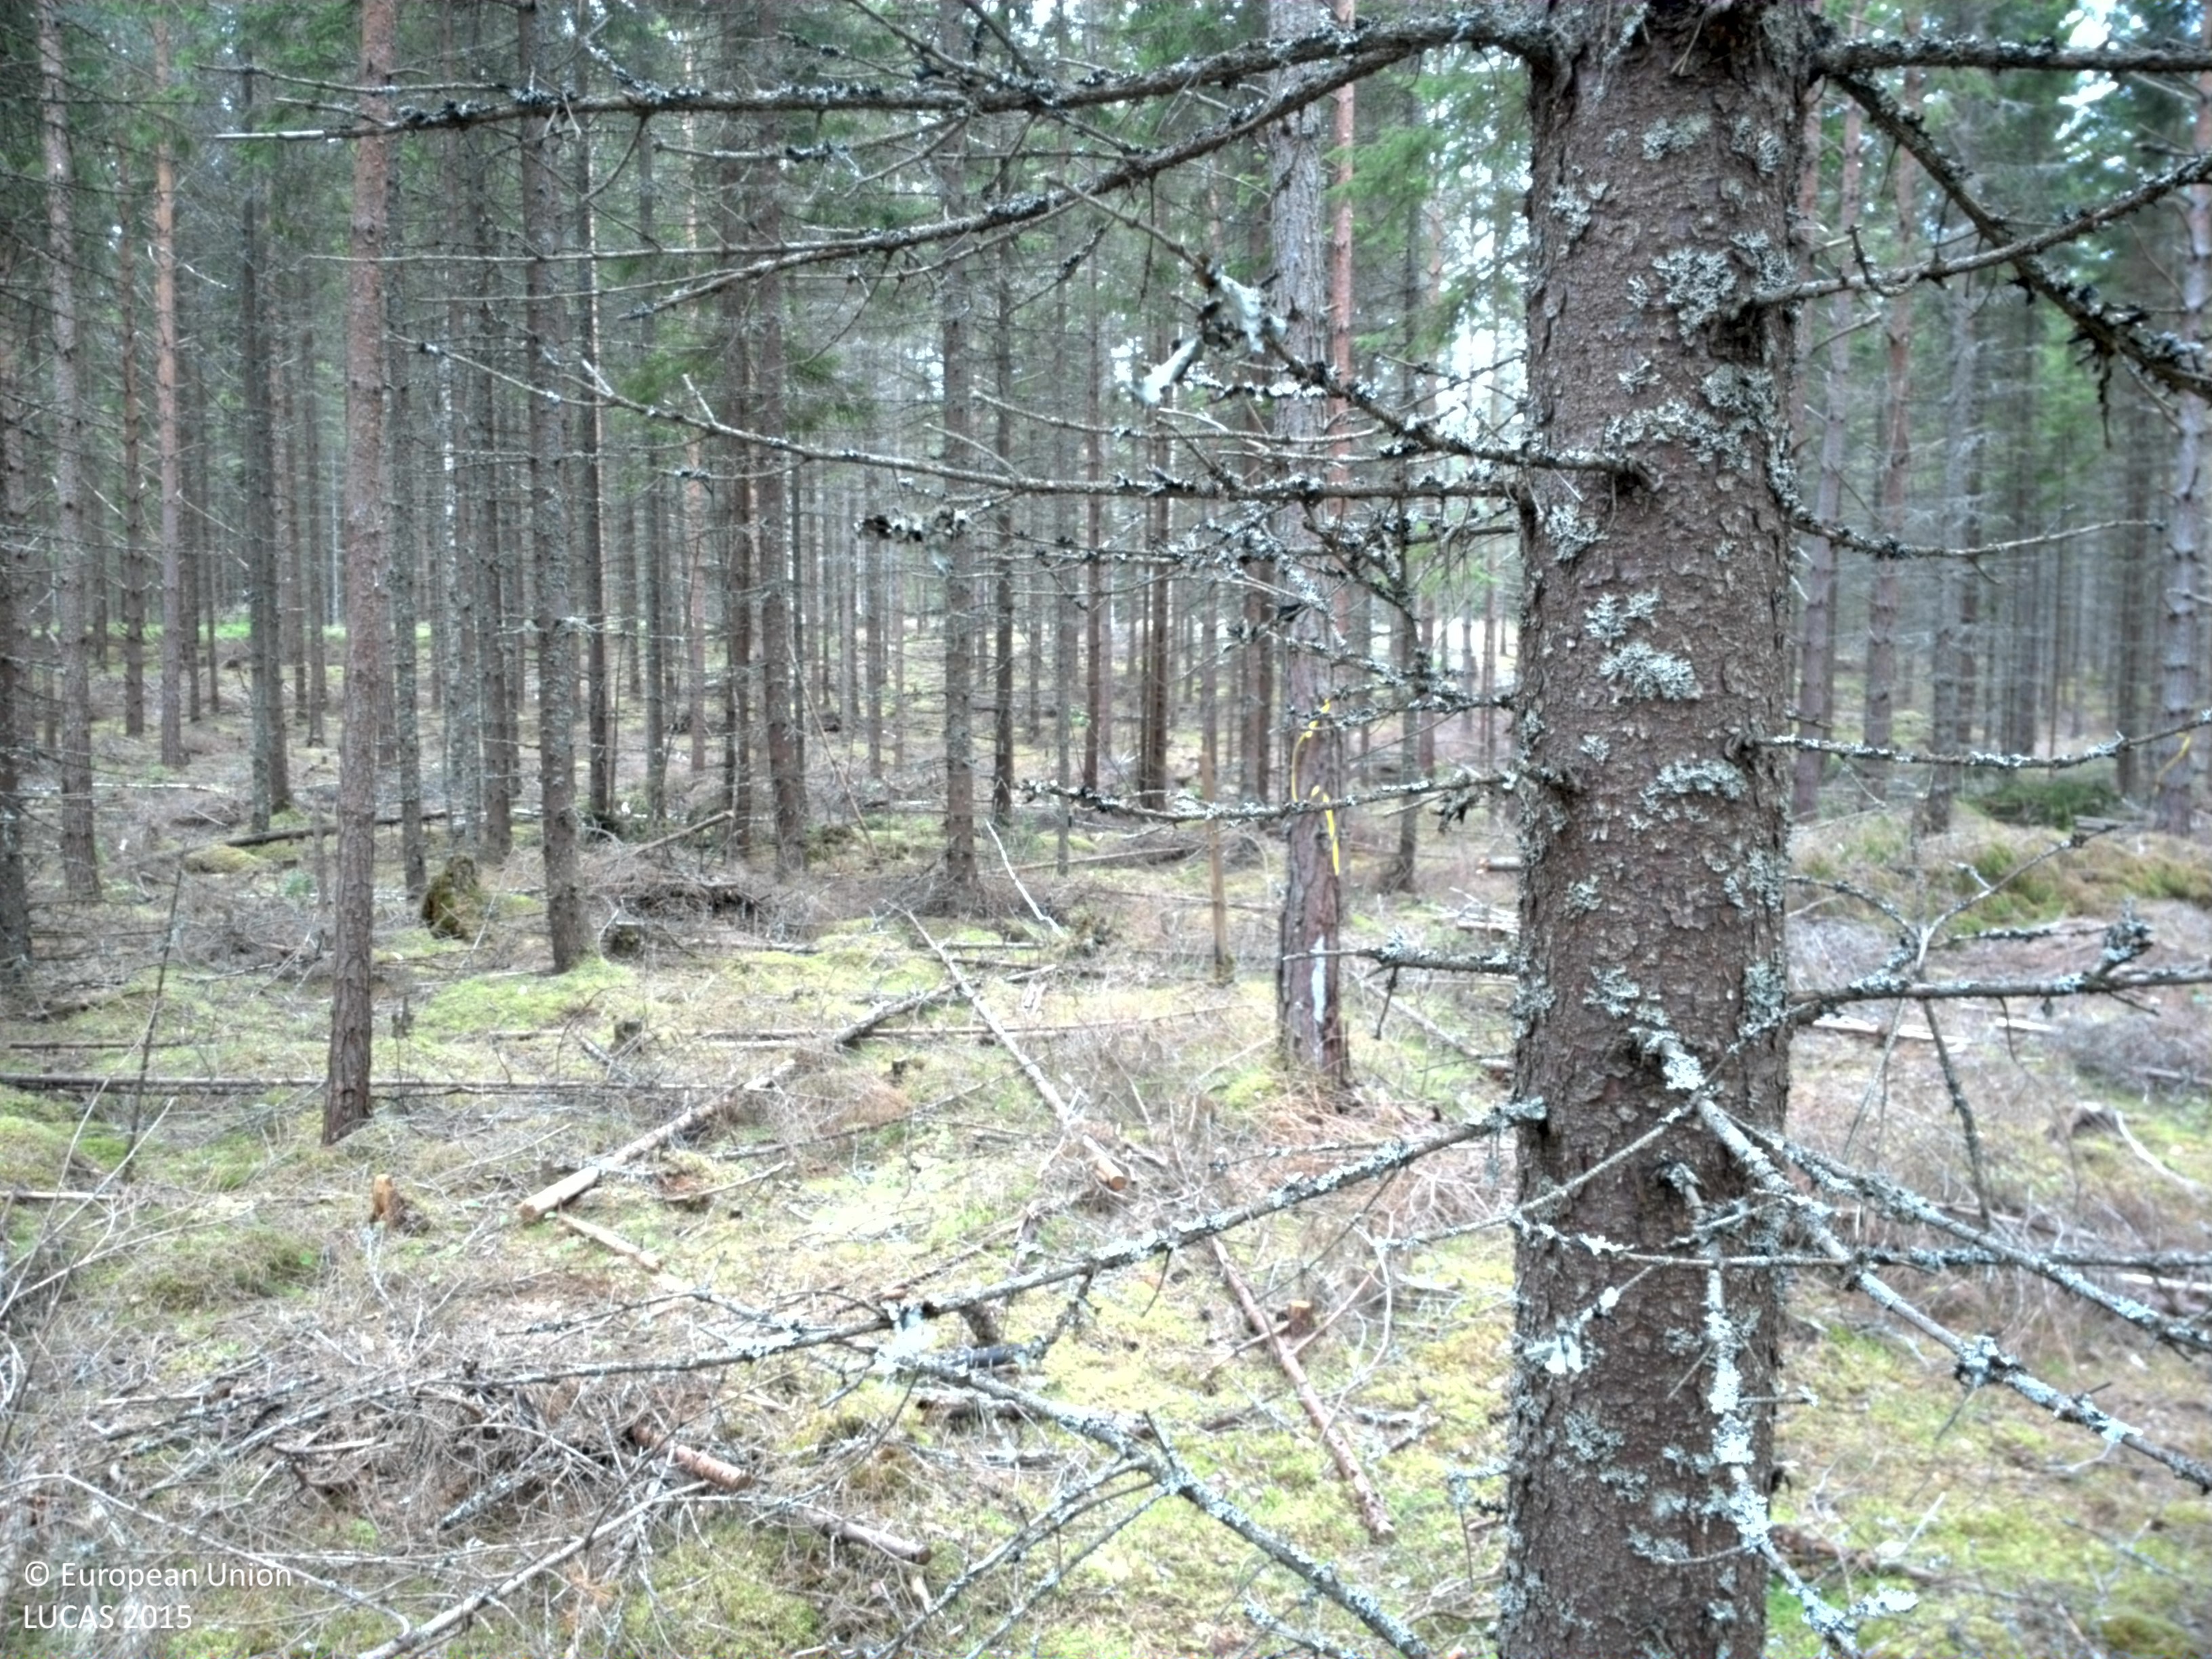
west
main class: Woodland
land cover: Spruce dominated coniferous woodland
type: boreal forest
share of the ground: 25 - 50 %
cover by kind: lichens and mosses 50 %, coniferous forest trees 45 %, herbaceous plants 5 %
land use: Forestry
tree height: > 5 m
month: July
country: SE
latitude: 58.9171
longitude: 14.5596
